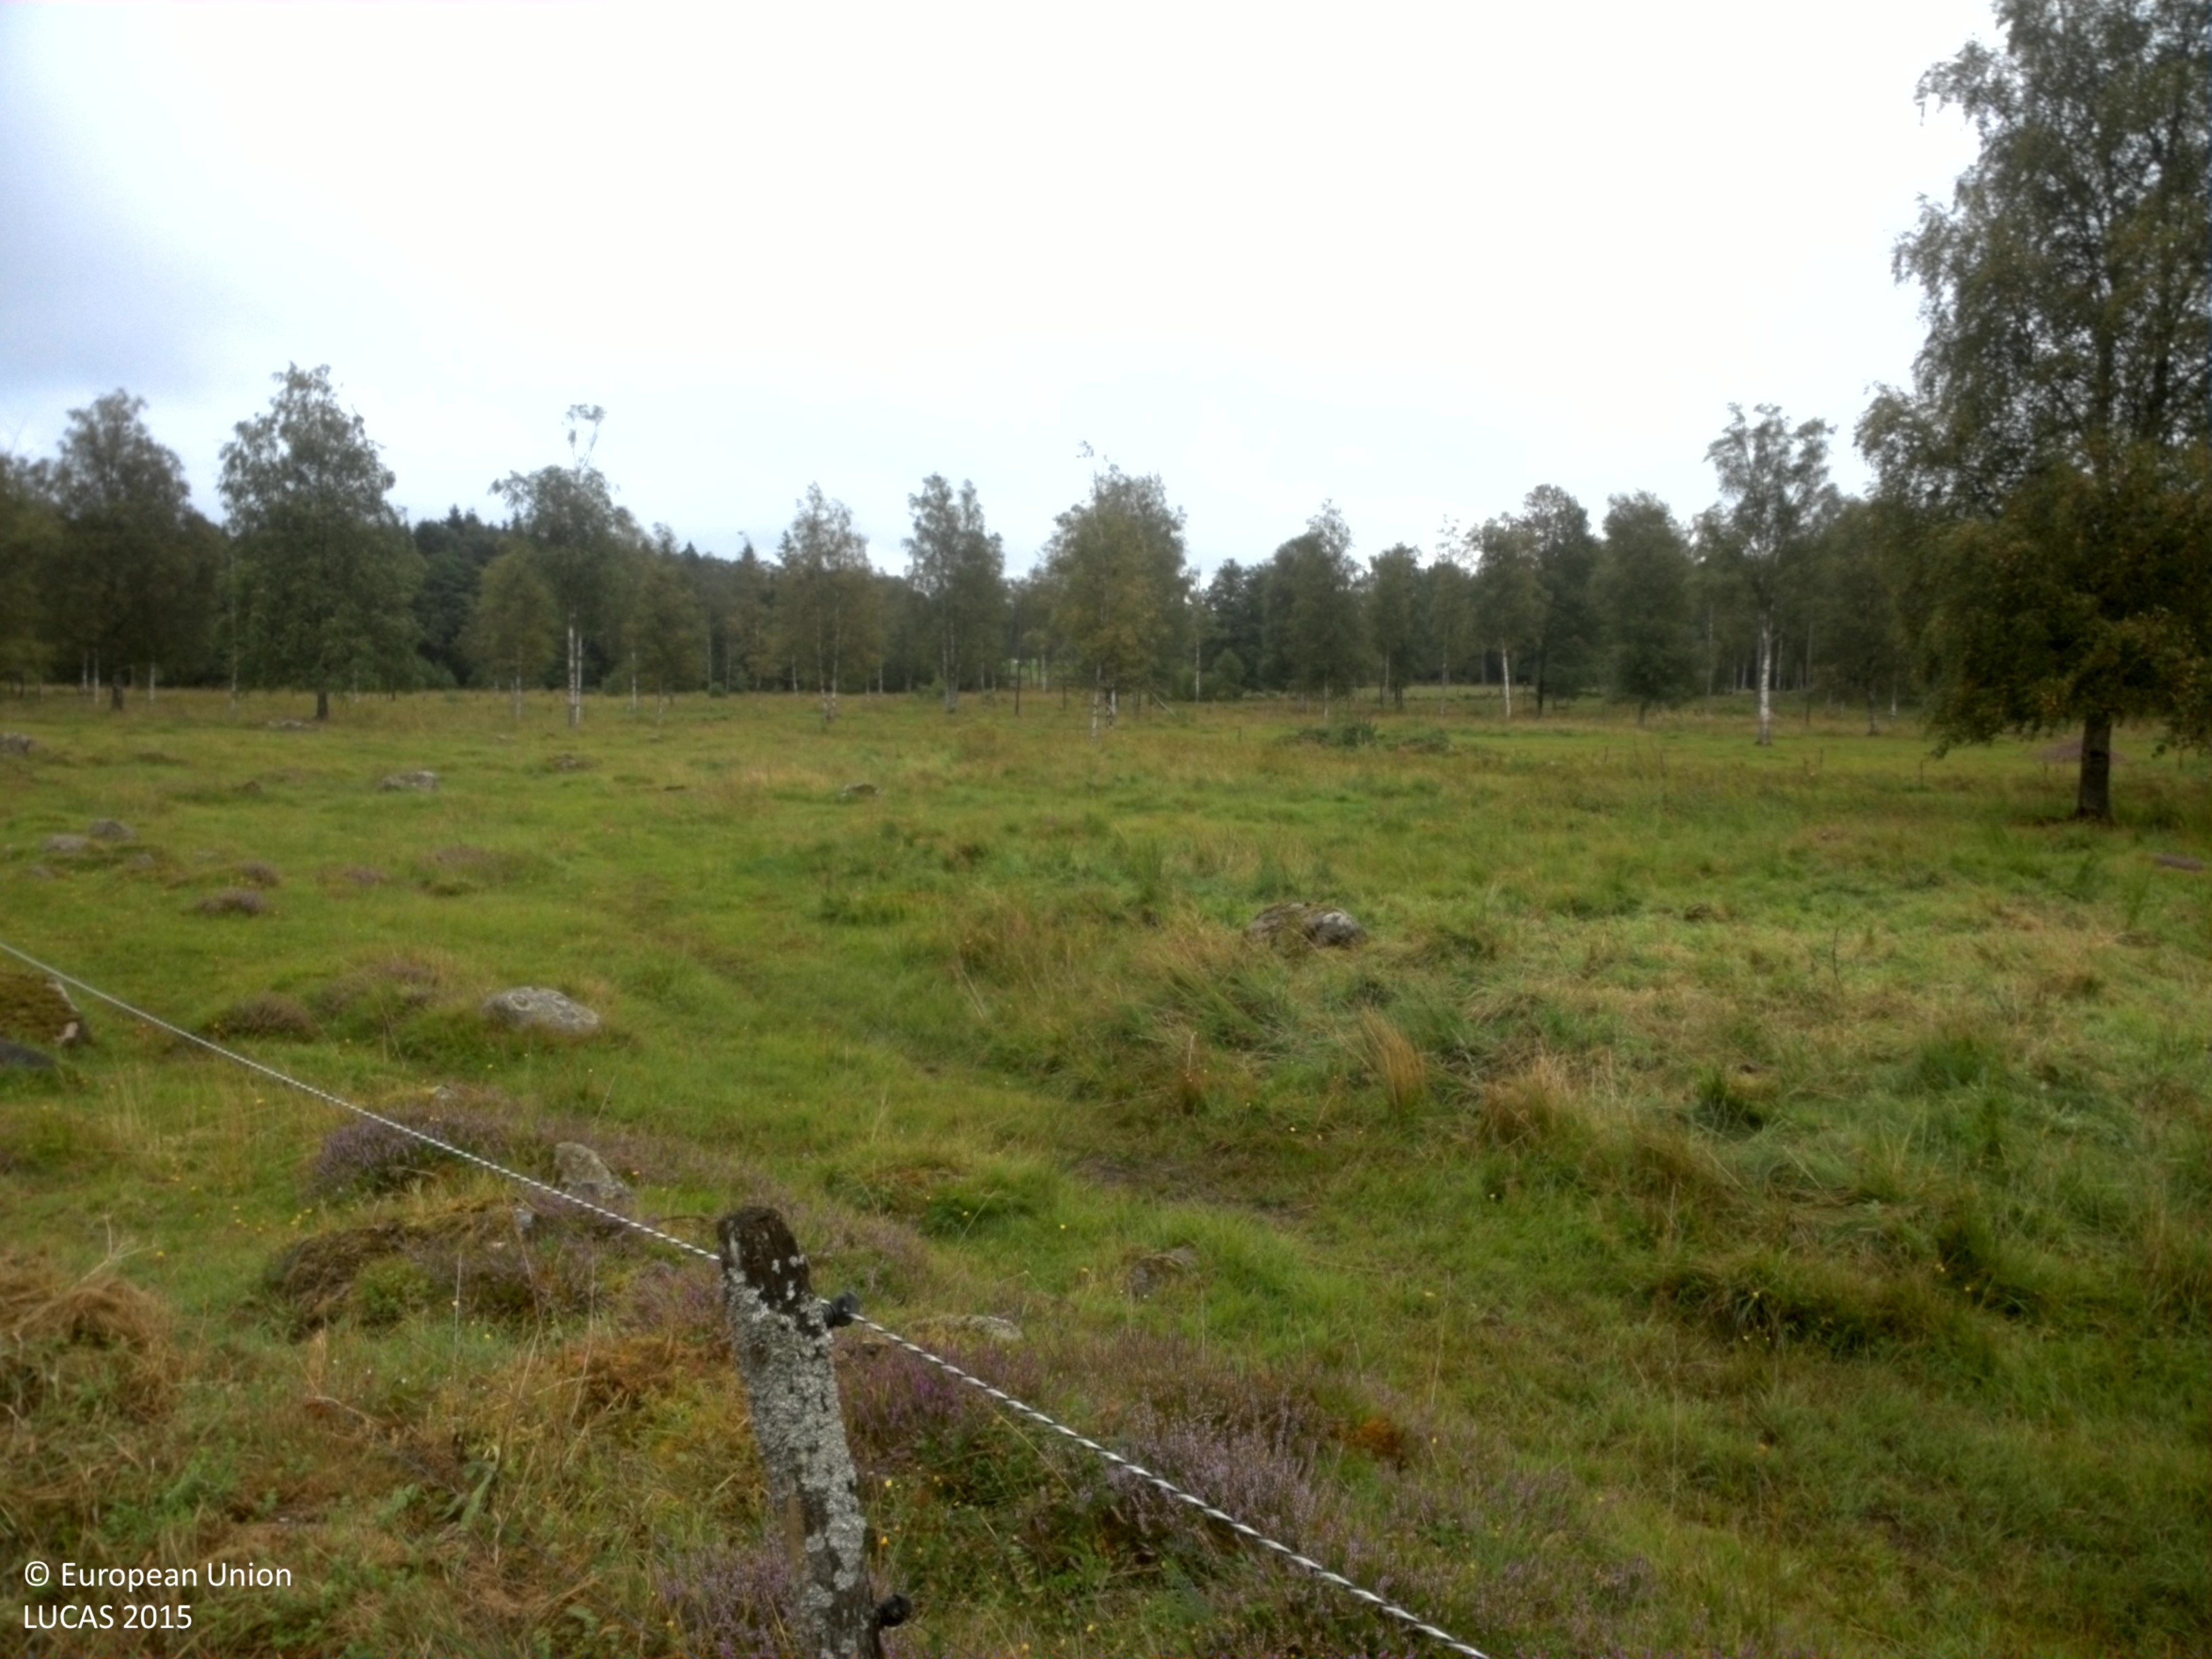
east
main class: Cropland
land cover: Temporary grasslands
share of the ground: > 75 %
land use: Agriculture (excluding fallow land and kitchen gardens)
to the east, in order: Temporary grasslands; Fences; Grassland without tree/shrub cover; Fences; Shruby margins; Ditches and canals; Shruby margins; Fences; Grassland with sparse tree/shrub cover; Ditches and canals; Grassland with sparse tree/shrub cover; Fences; Shruby margins; Ditches and canals; Shruby margins; Electric lines; Fences; Grassland with sparse tree/shrub cover; Fences; Grass margins; Fences; Grassland without tree/shrub cover; Spruce dominated mixed woodland
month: August
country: SE
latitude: 57.8415
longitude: 13.1116
